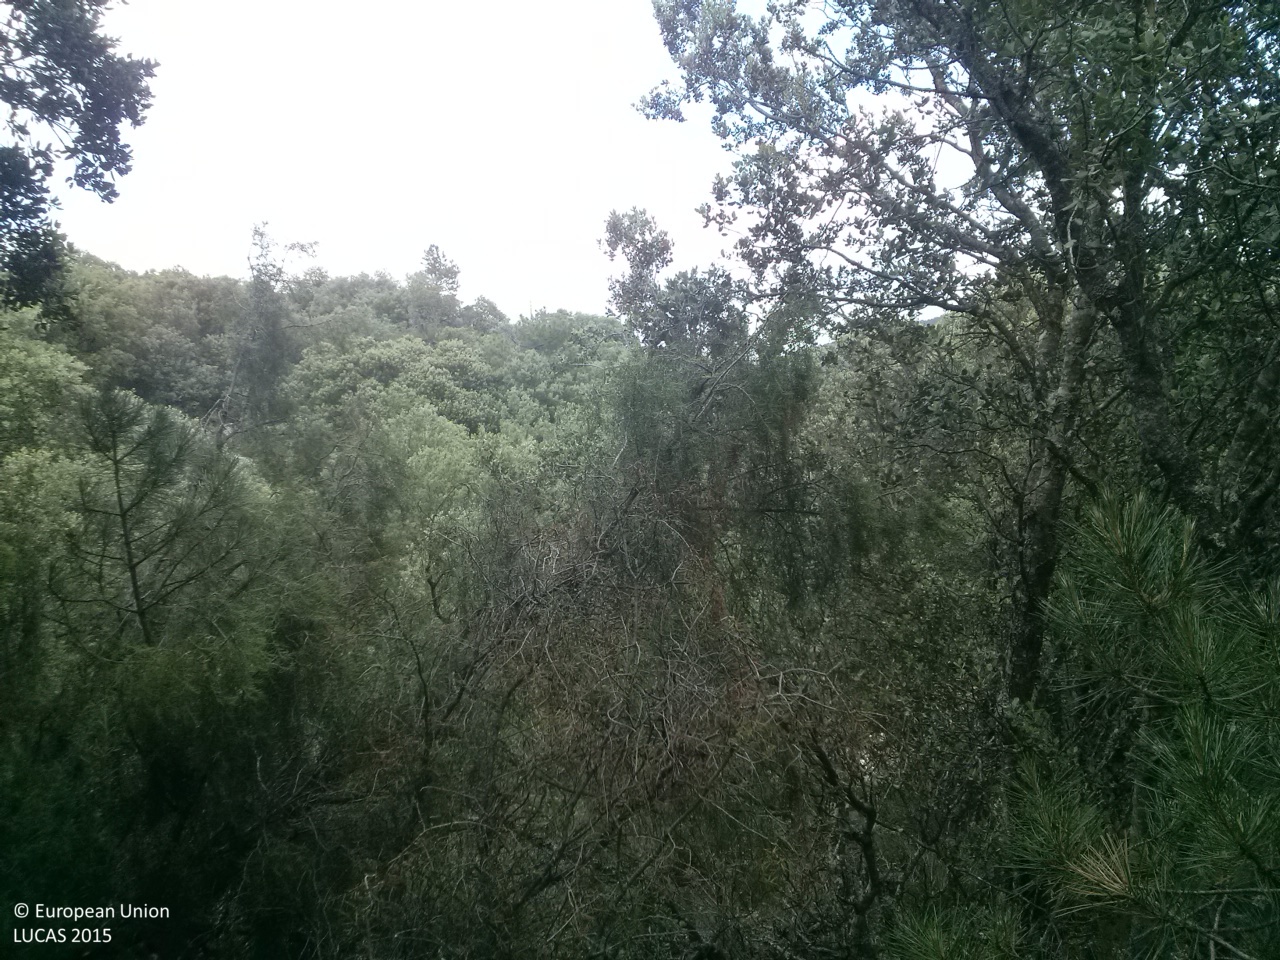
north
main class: Woodland
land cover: Pine dominated mixed woodland
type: coniferous forest of the mediterranean region
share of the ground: 50 - 75 %
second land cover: Shrubland without tree cover
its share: 10 - 25 %
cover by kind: coniferous forest trees 35 %, broadleaved forest trees 35 %, shrubs 20 %, herbaceous plants 10 %
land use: Forestry
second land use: Agriculture (excluding fallow land and kitchen gardens)
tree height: > 5 m
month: June
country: ES
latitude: 39.9053
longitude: -1.6013
